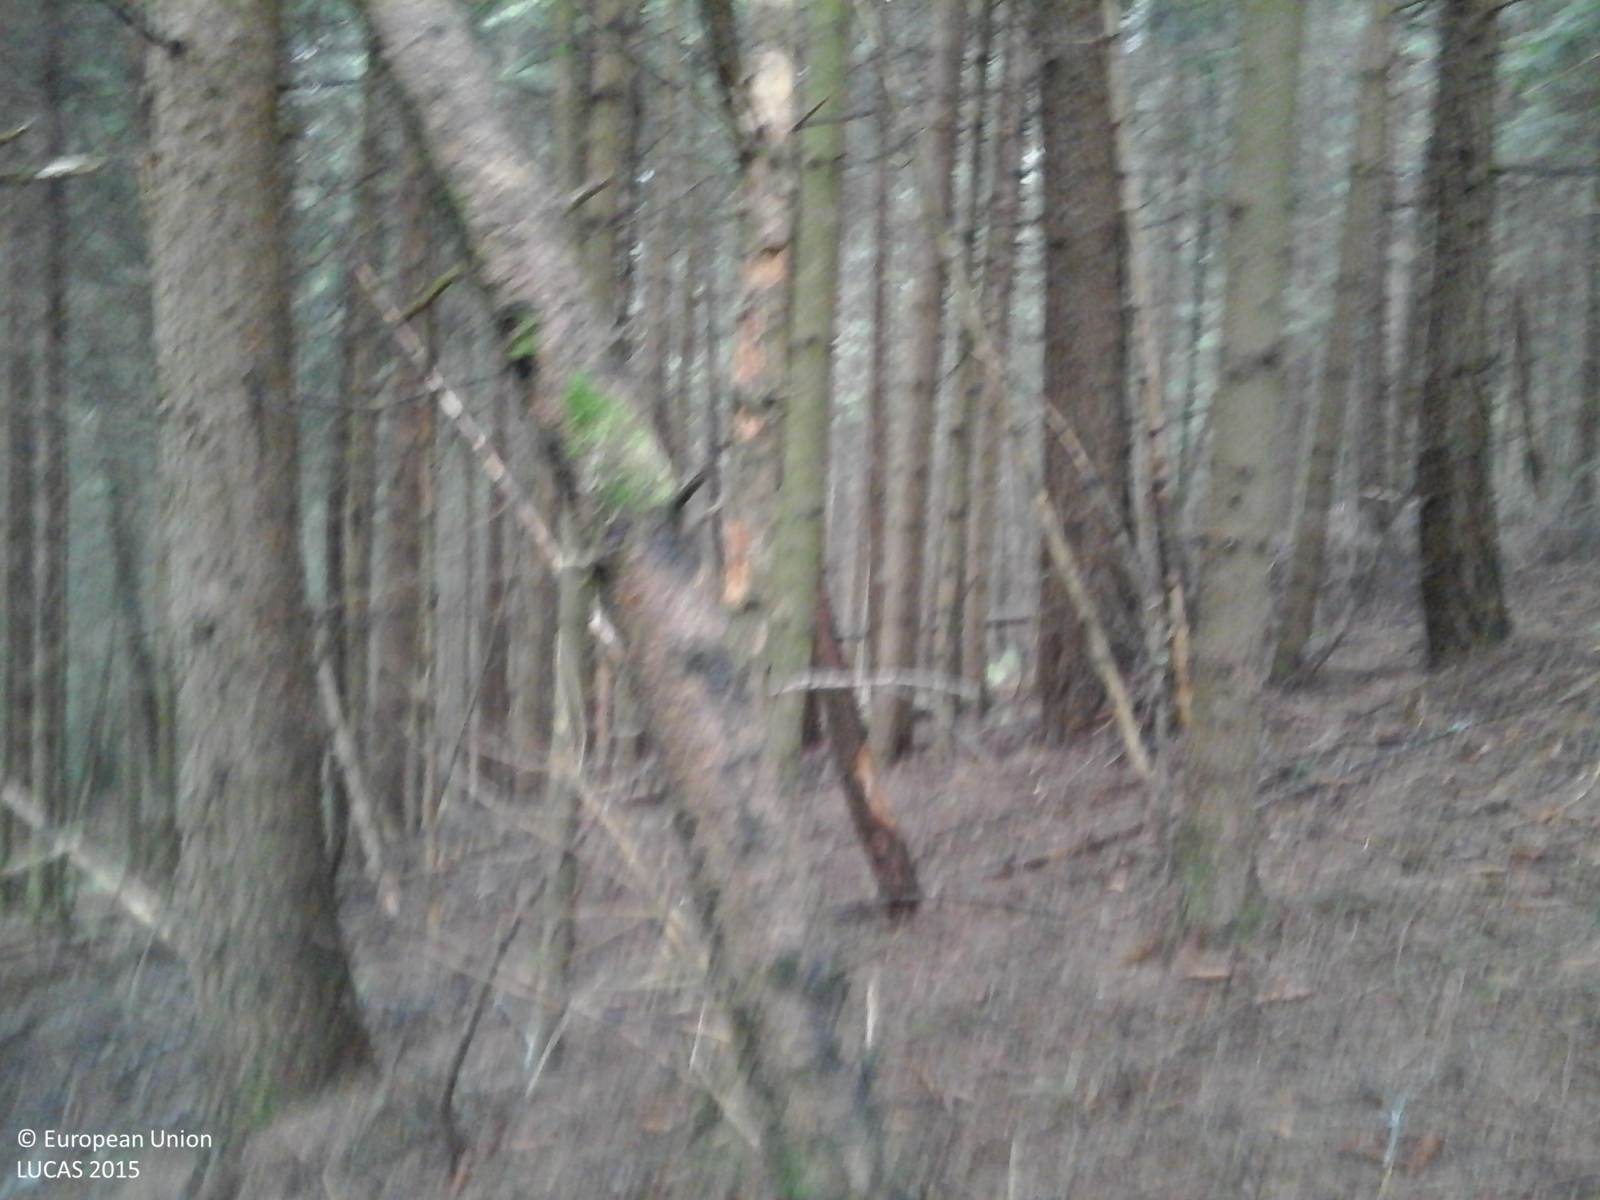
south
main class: Woodland
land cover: Spruce dominated coniferous woodland
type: alpine coniferous forest
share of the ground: > 75 %
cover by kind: coniferous forest trees 100 %
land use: Forestry
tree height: > 5 m
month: May
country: IT
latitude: 46.0328
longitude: 11.6128
